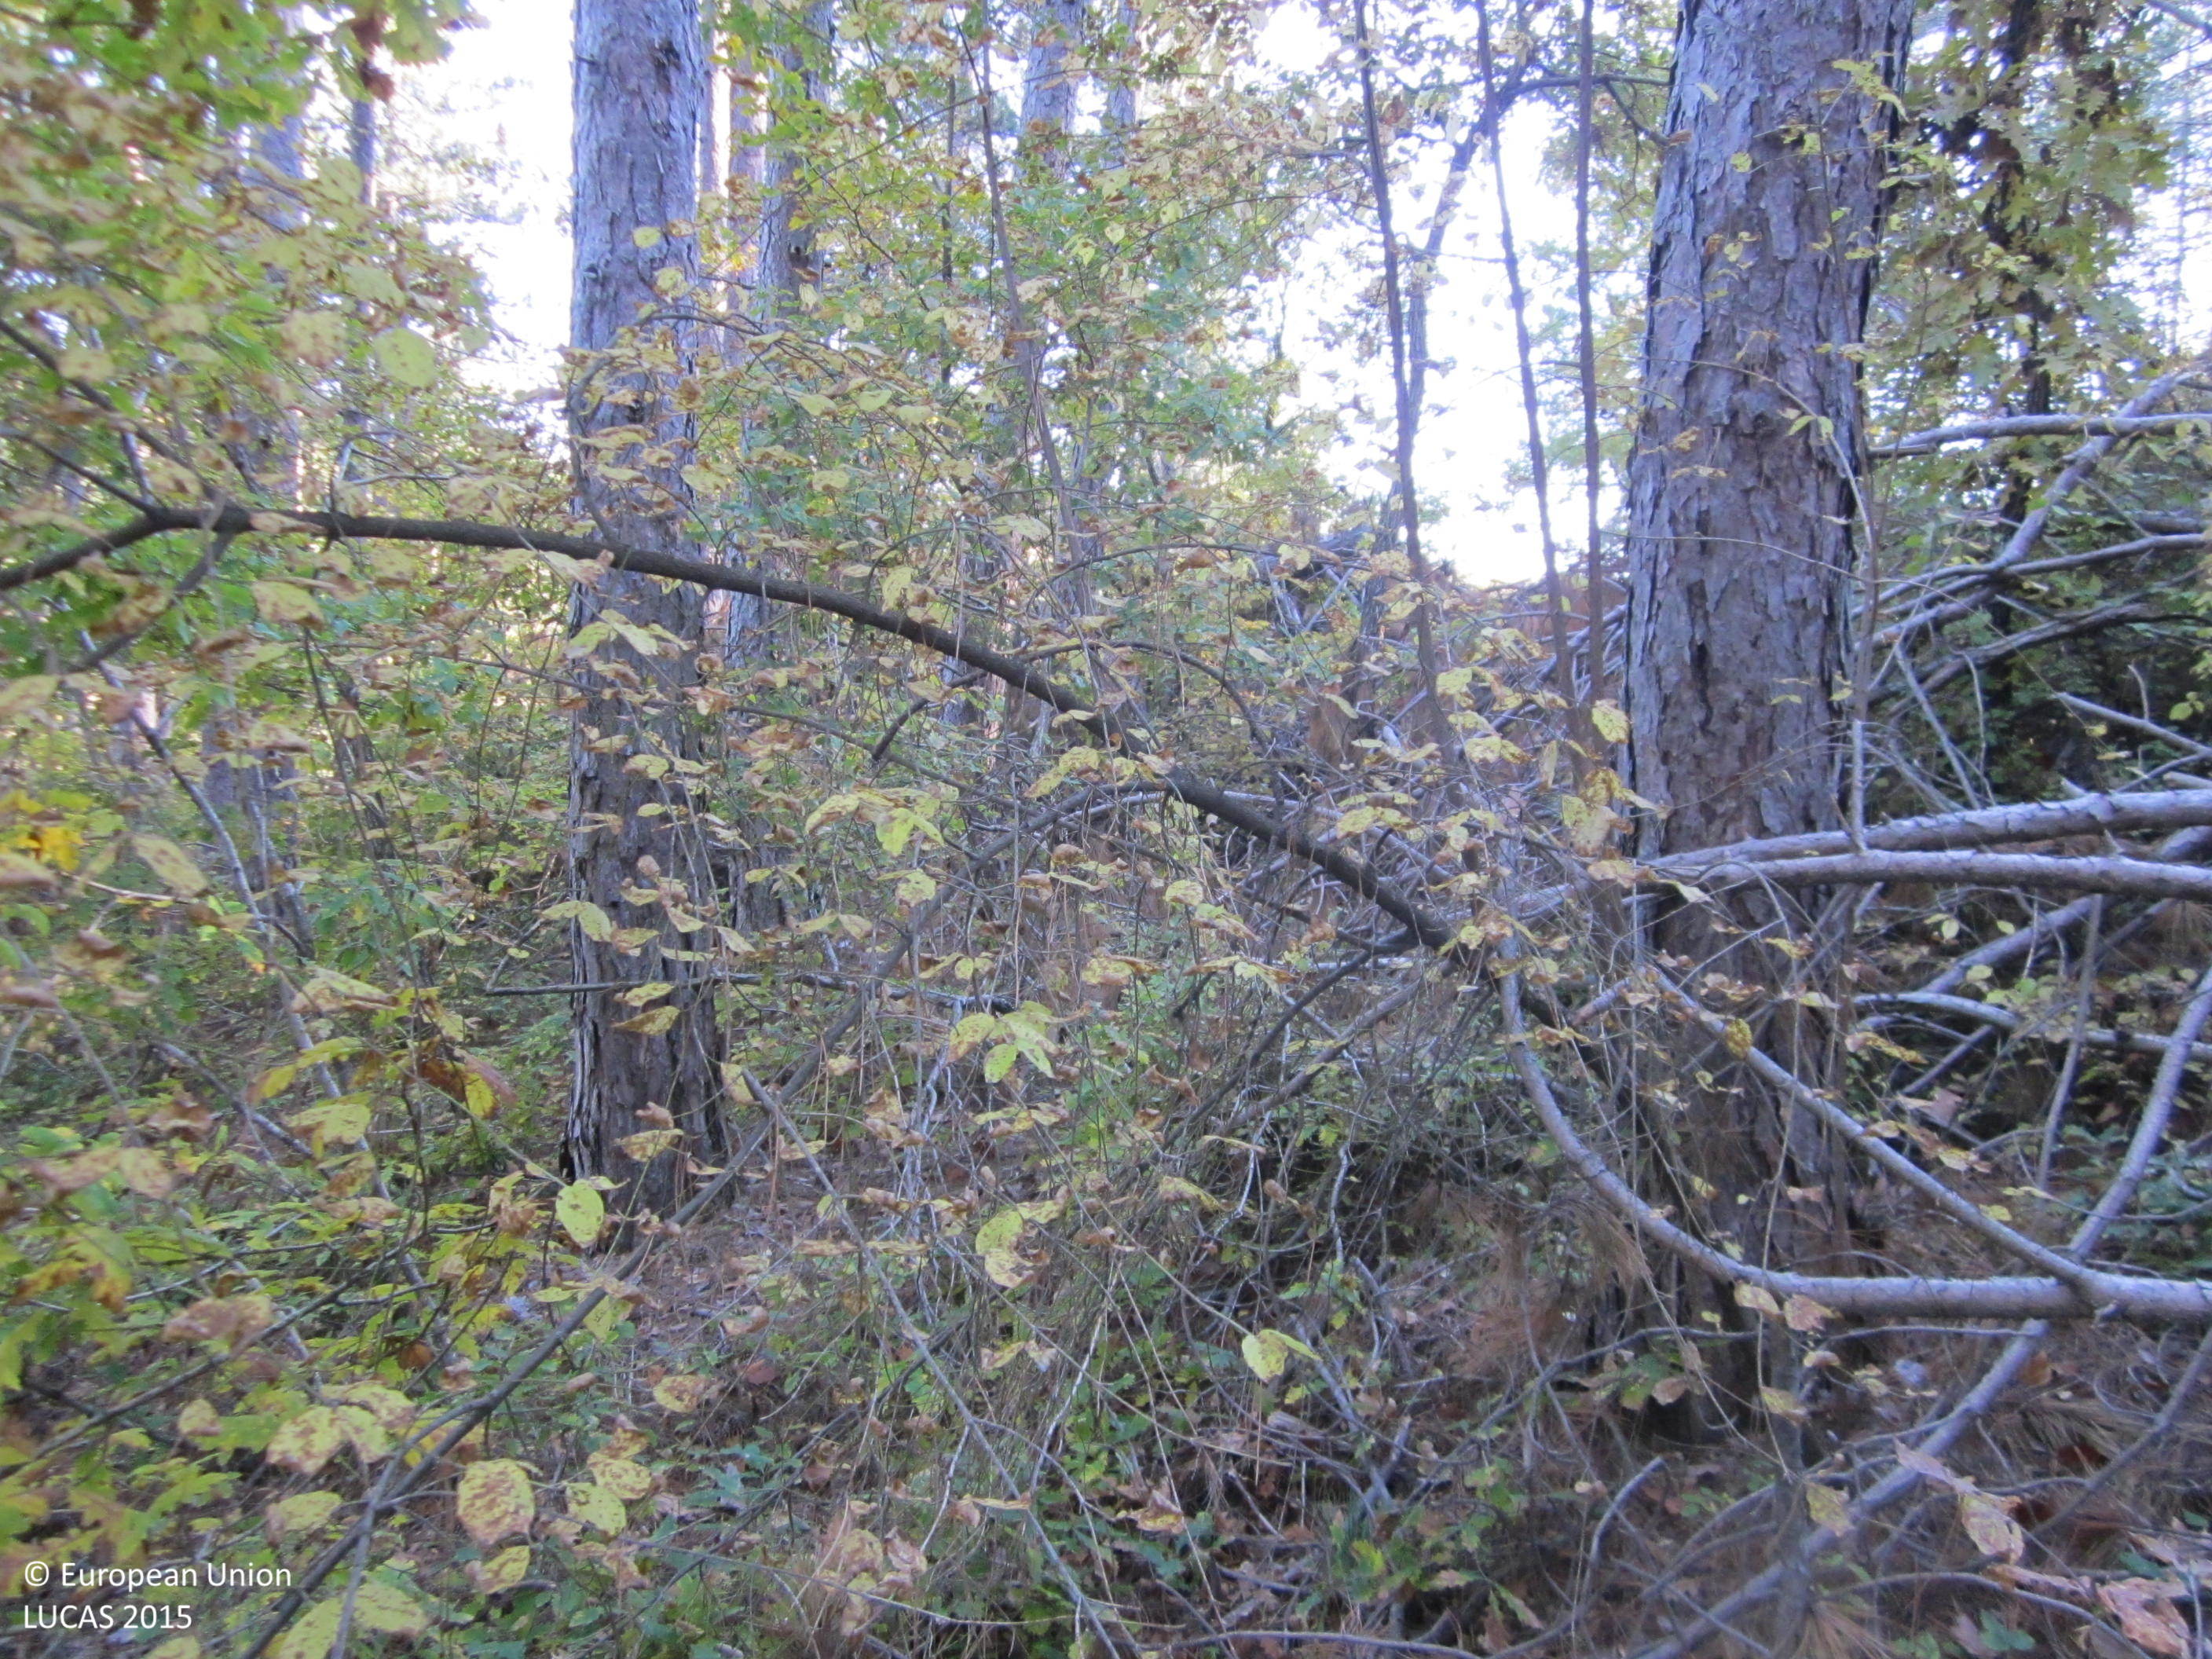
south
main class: Woodland
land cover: Pine dominated coniferous woodland
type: hemiboreal forest and nemoral coniferous forest and mixed broadleaved-coniferous forest
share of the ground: > 75 %
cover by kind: coniferous forest trees 60 %, broadleaved forest trees 20 %, unconsolidated bare surface 15 %, shrubs 5 %
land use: Forestry
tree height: > 5 m
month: November
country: BG
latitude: 41.3707
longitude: 25.7832
